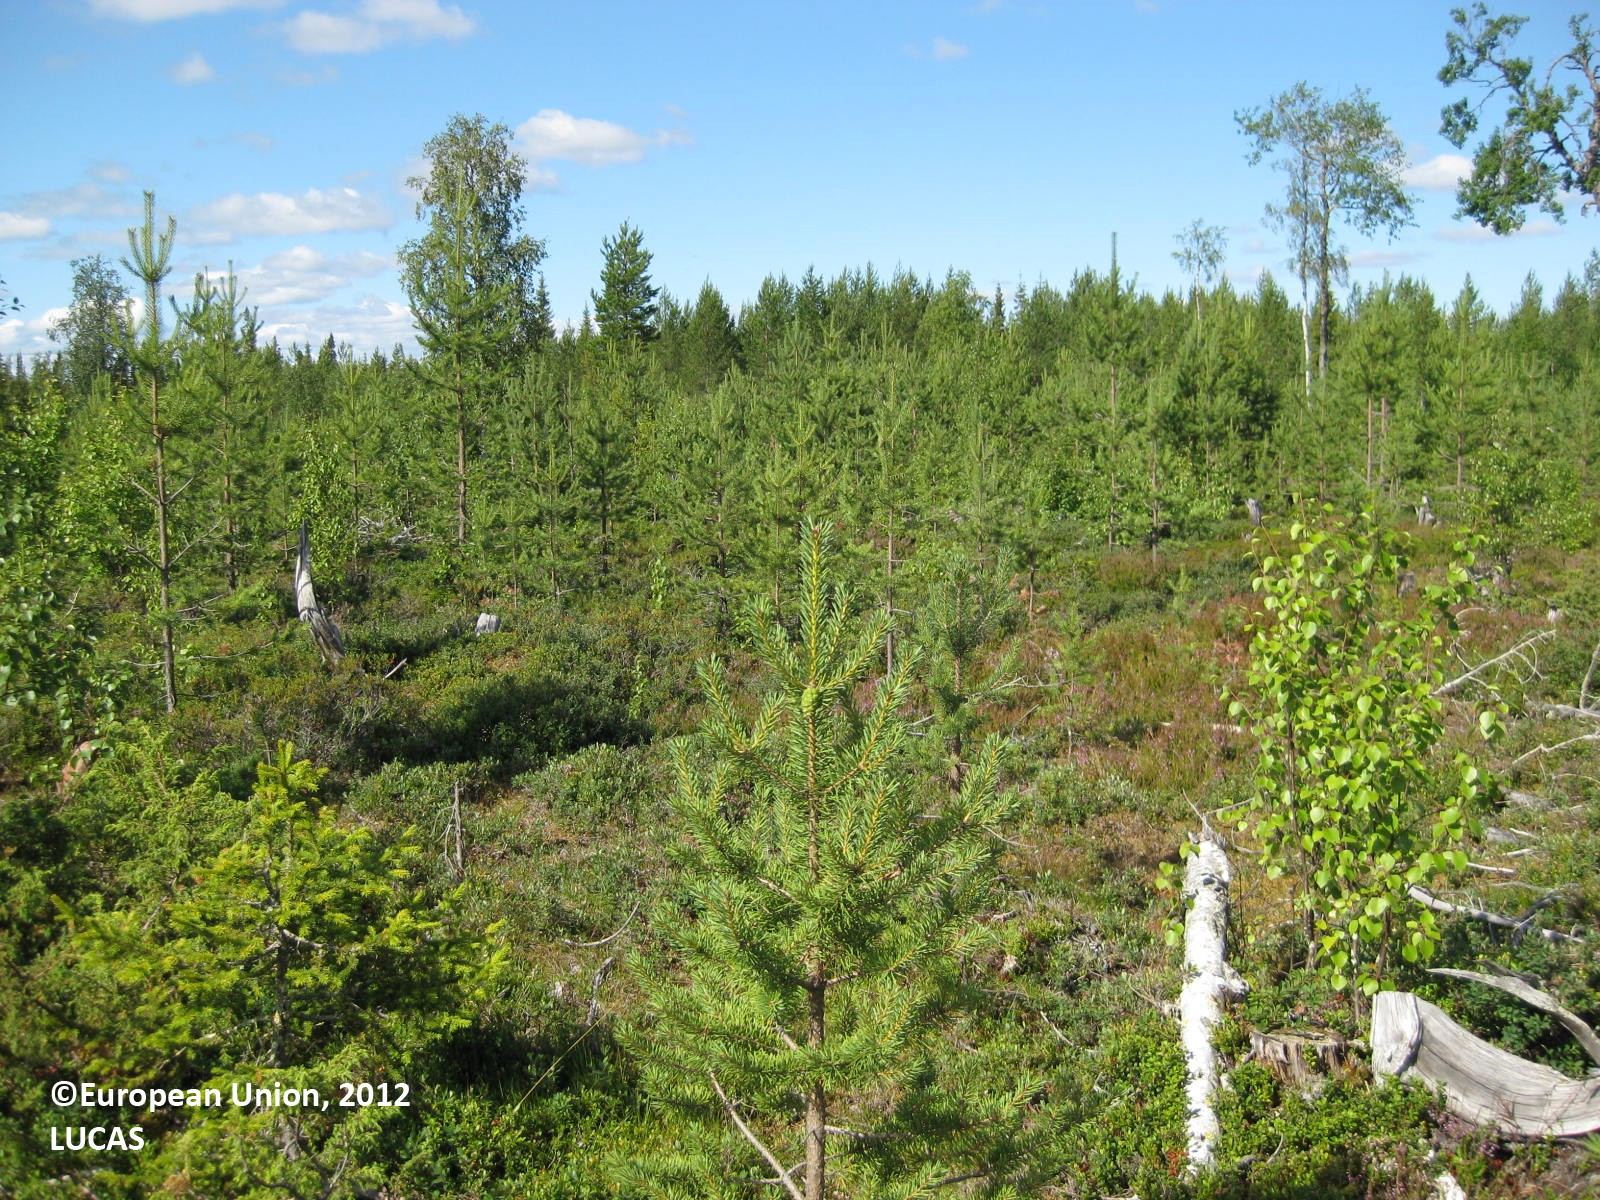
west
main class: Woodland
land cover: Pine dominated mixed woodland
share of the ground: 50 - 75 %
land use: Forestry
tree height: < 5 m
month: July
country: FI
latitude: 65.6735
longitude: 28.4539
